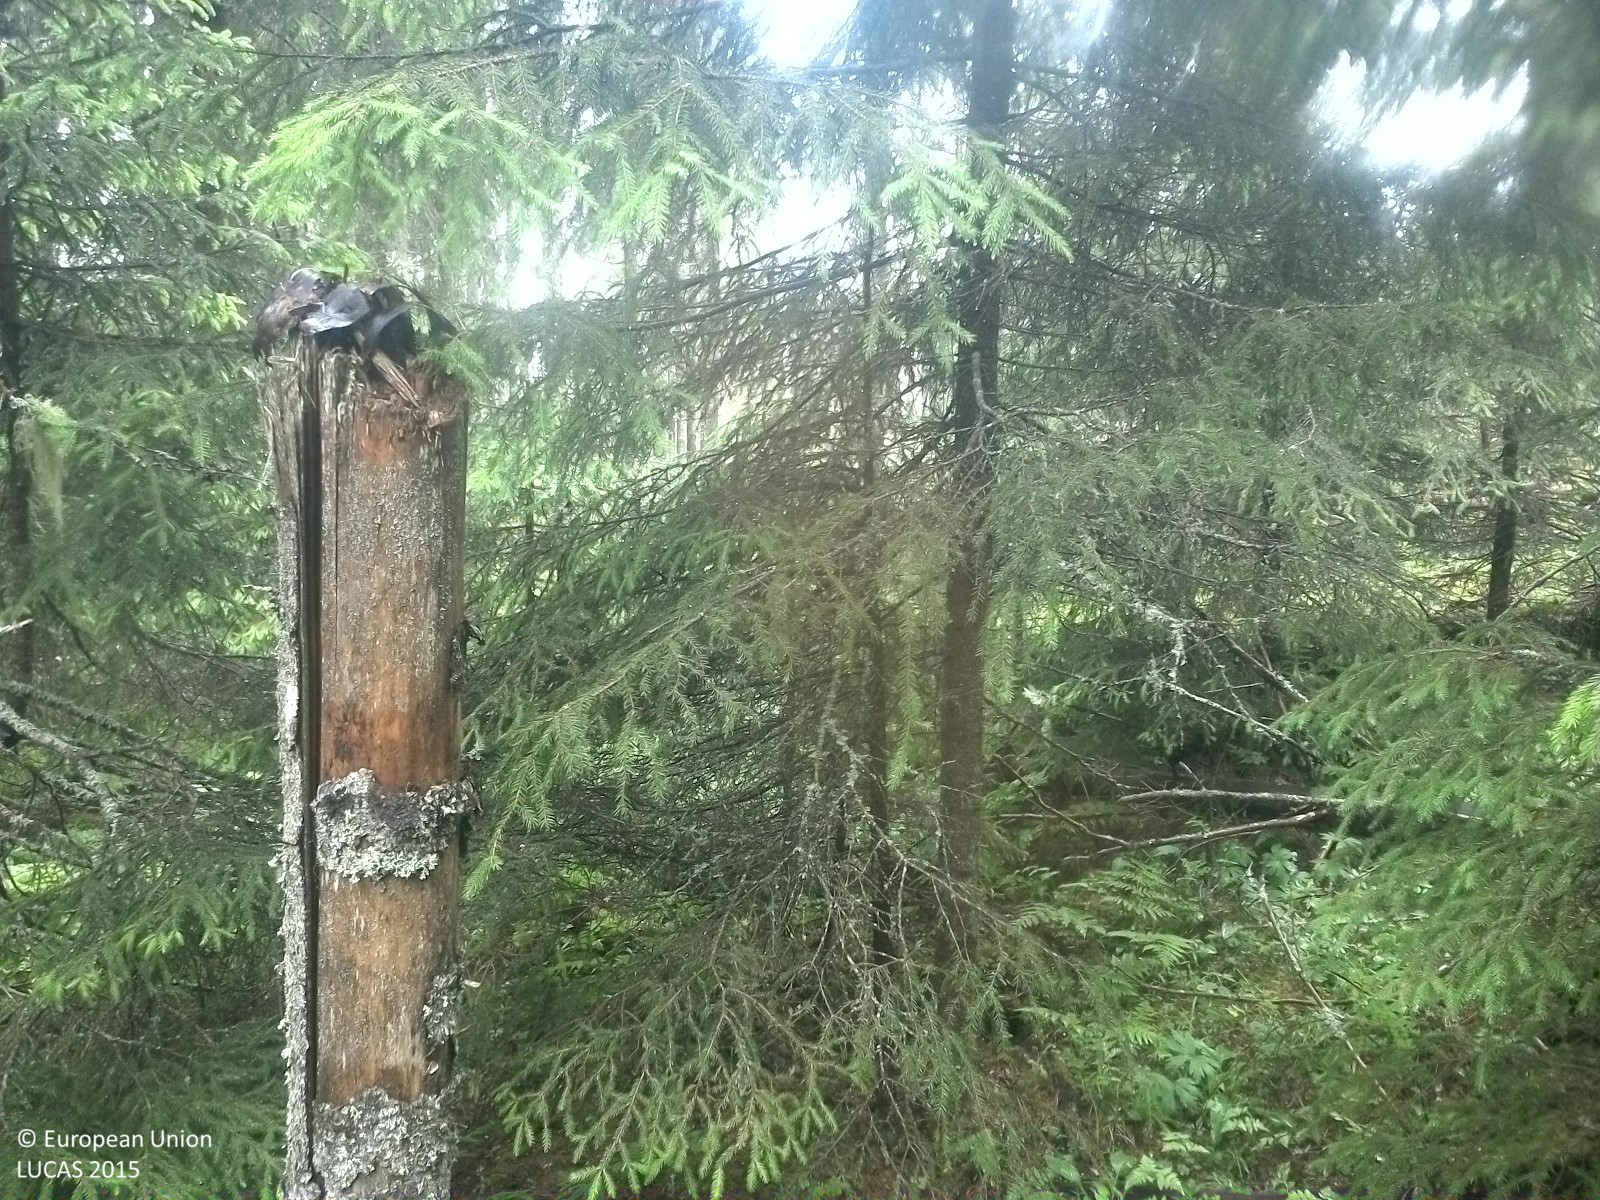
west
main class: Woodland
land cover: Spruce dominated mixed woodland
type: boreal forest
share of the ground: 50 - 75 %
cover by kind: coniferous forest trees 40 %, herbaceous plants 30 %, broadleaved forest trees 20 %, lichens and mosses 10 %
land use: Forestry
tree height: > 5 m
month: July
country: SE
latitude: 62.4756
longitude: 16.8265
